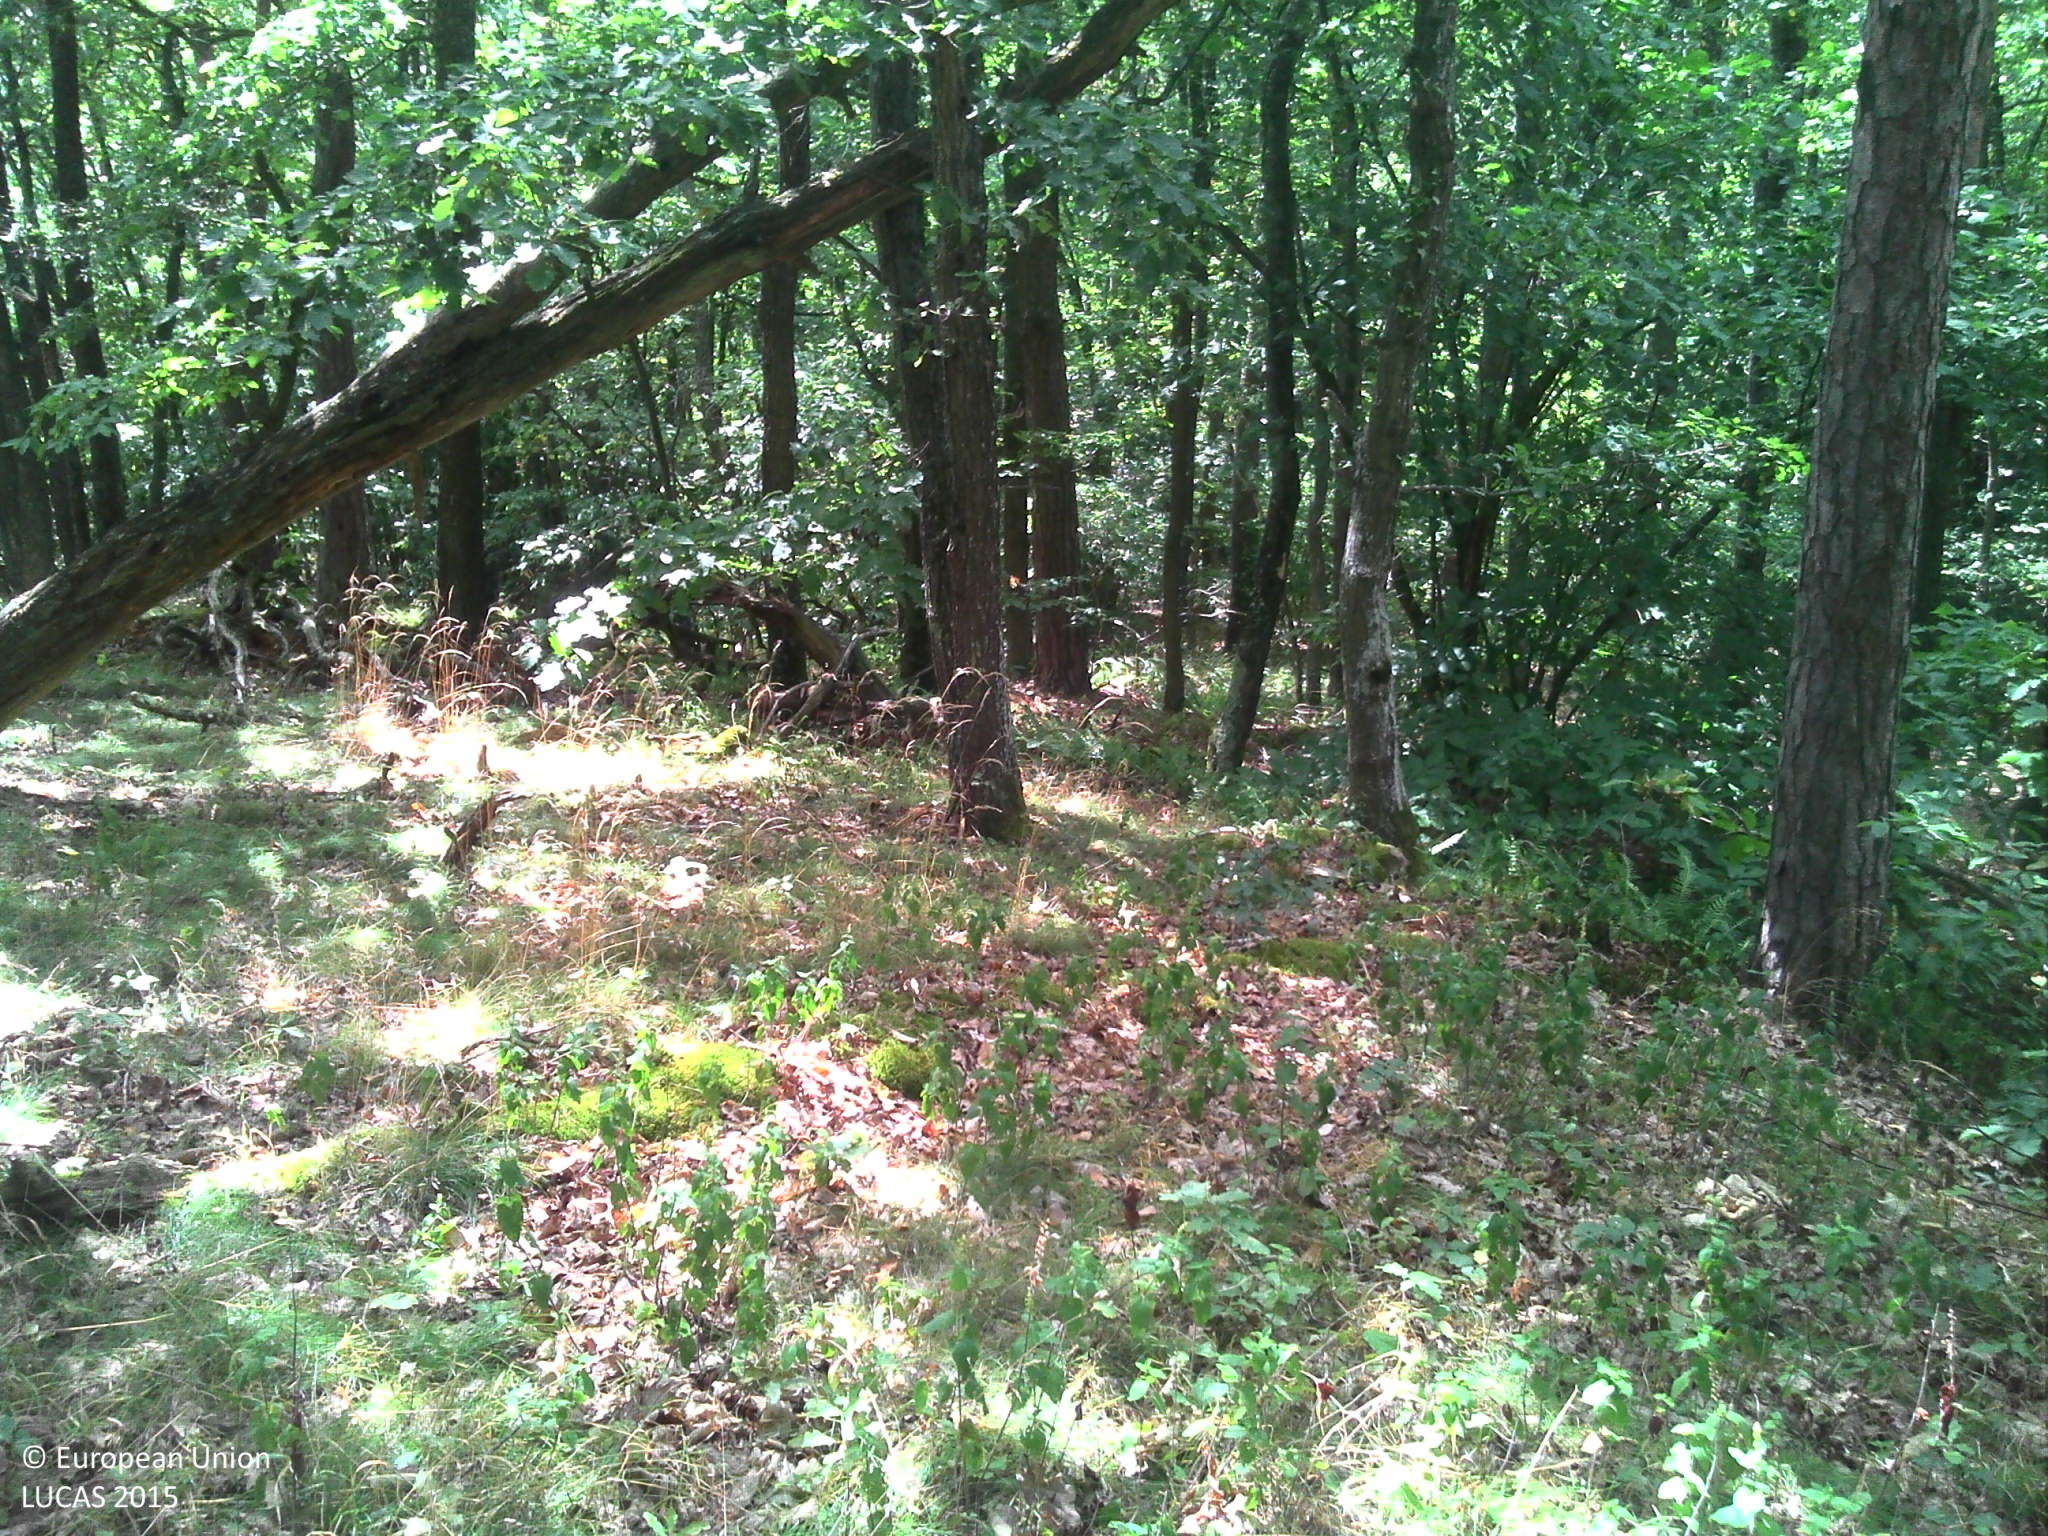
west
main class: Woodland
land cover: Broadleaved woodland
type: acidophilous oak and oak-birch forest
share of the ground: > 75 %
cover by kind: broadleaved forest trees 80 %, herbaceous plants 20 %
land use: Forestry
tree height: > 5 m
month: July
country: FR
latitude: 45.7204
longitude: 4.4657
